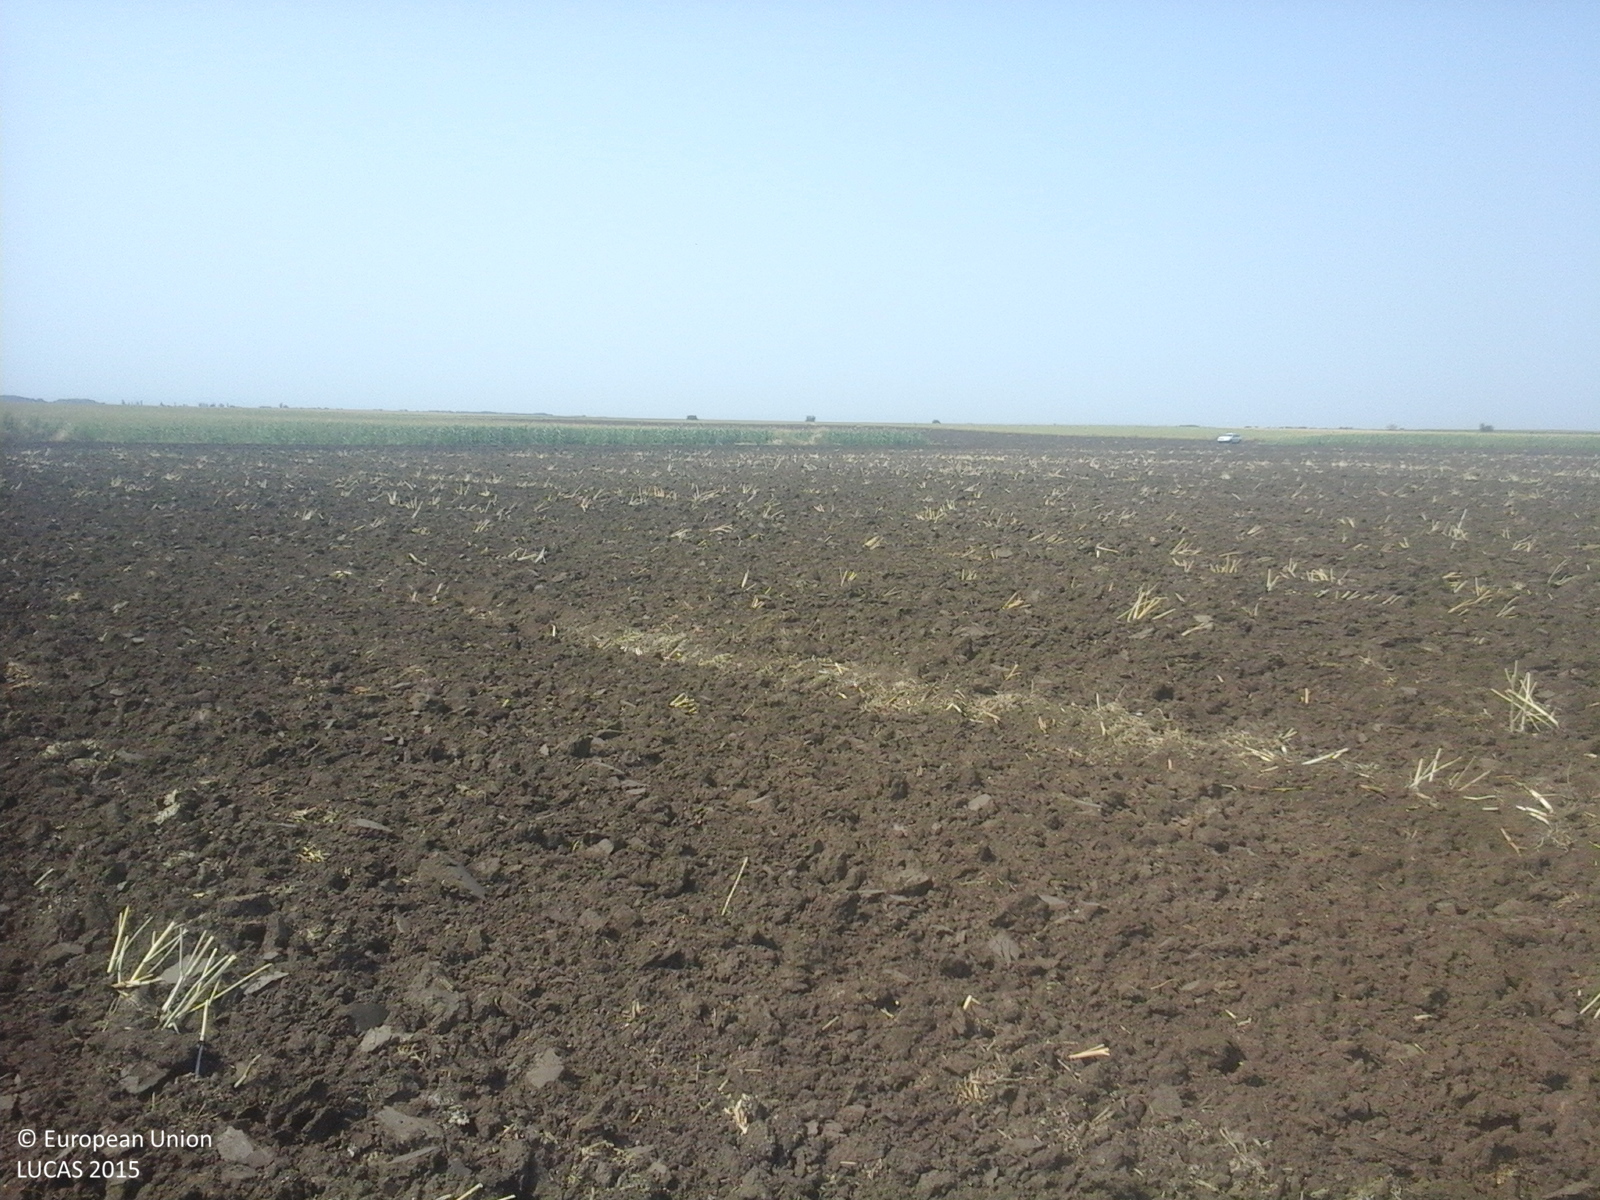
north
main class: Cropland
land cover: Rape and turnip rape
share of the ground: < 10 %
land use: Agriculture (excluding fallow land and kitchen gardens)
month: July
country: RO
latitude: 44.9124
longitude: 26.8360
